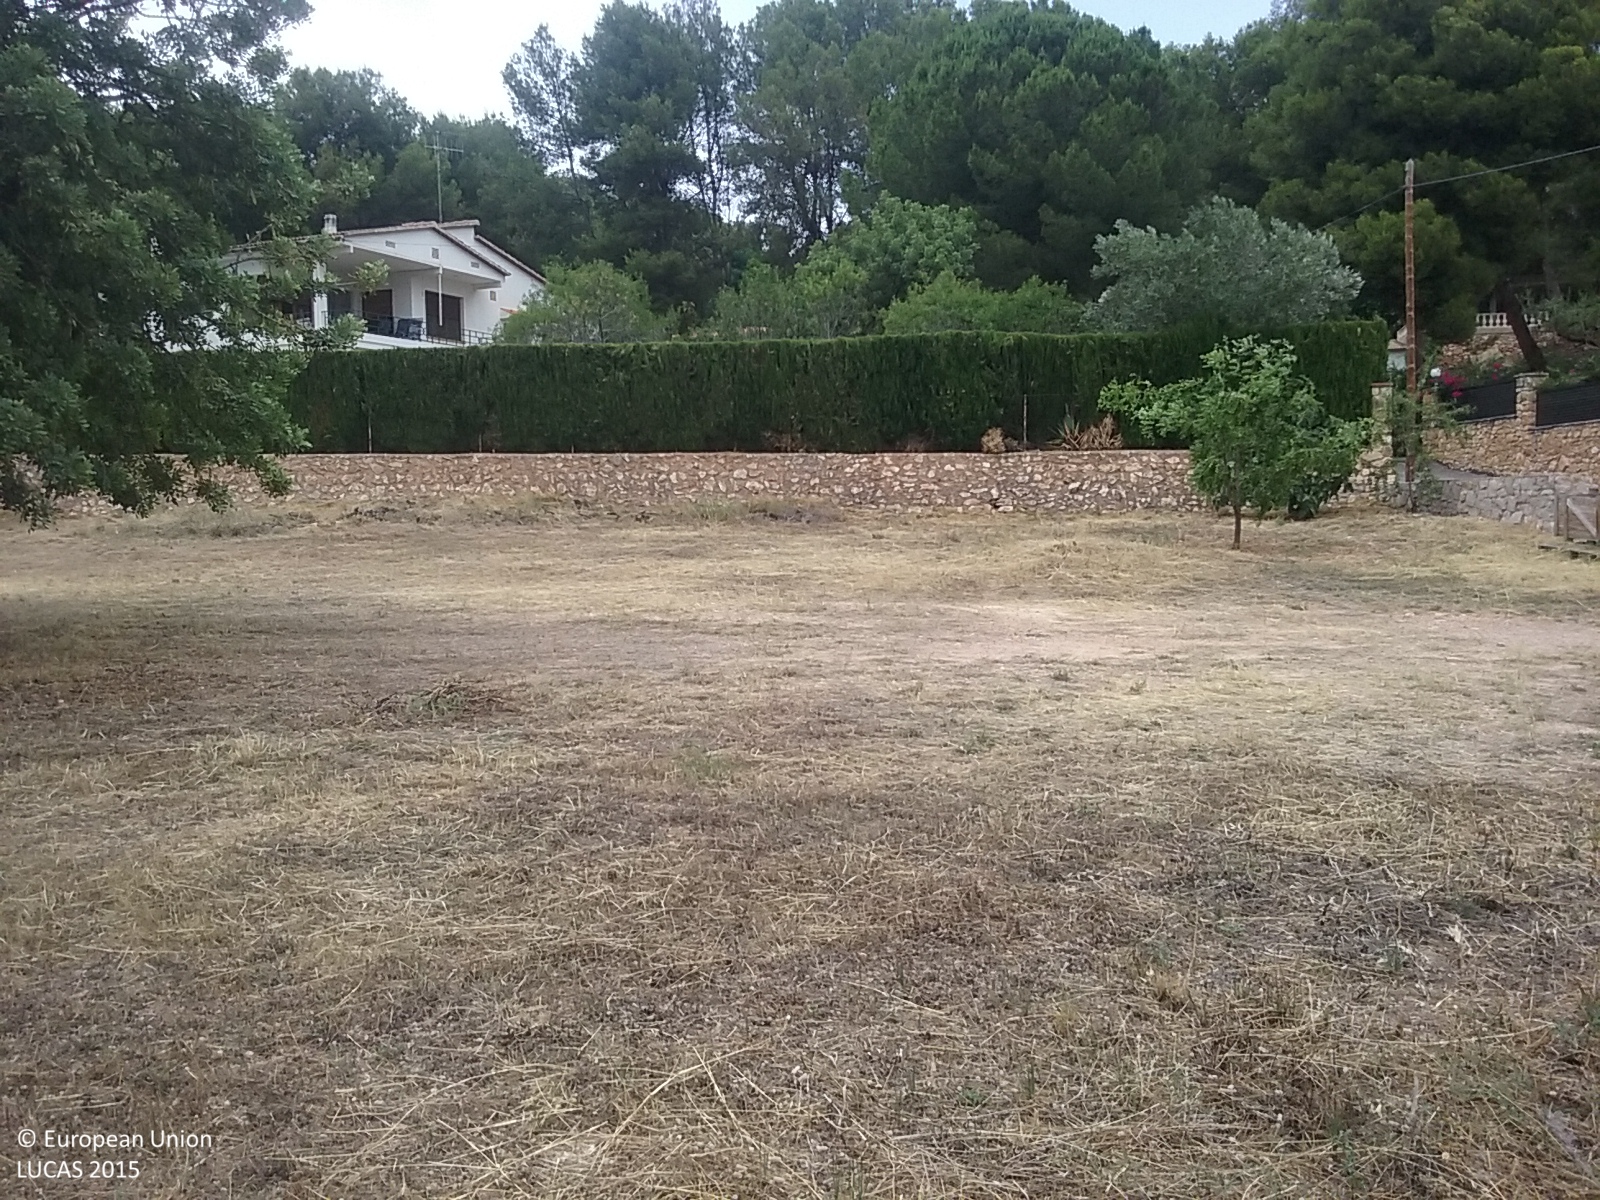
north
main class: Grassland
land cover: Grassland with sparse tree/shrub cover
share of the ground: > 75 %
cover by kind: herbaceous plants 90 %, coniferous forest trees 5 %, unconsolidated bare surface 5 %
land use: Abandoned areas
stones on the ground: > 50 %
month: July
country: ES
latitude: 40.0144
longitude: -0.1358
